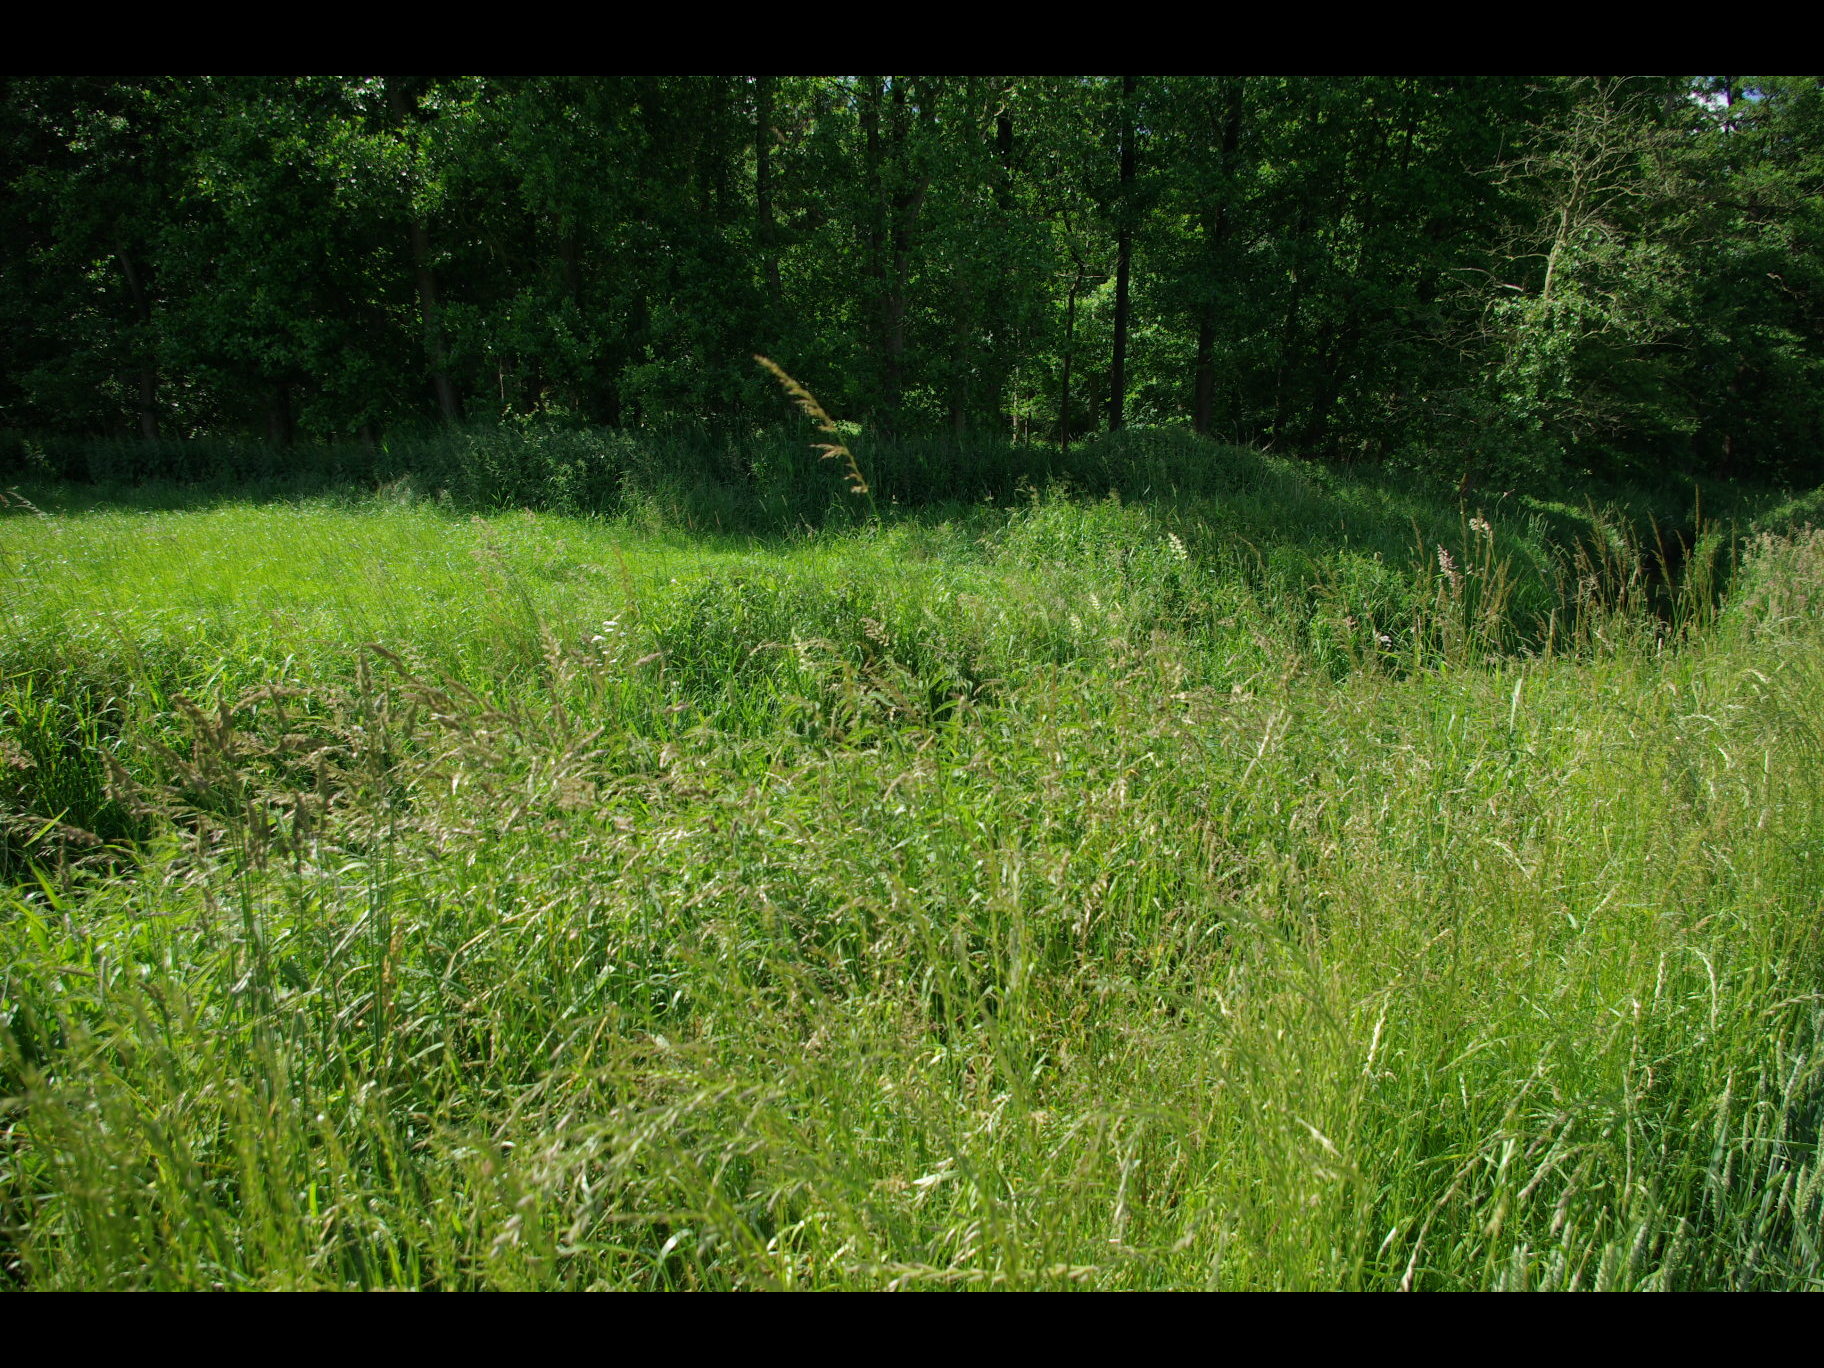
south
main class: Cropland
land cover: Common wheat
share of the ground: > 75 %
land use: Agriculture (excluding fallow land and kitchen gardens)
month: June
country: DE
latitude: 54.3724
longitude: 9.8923
